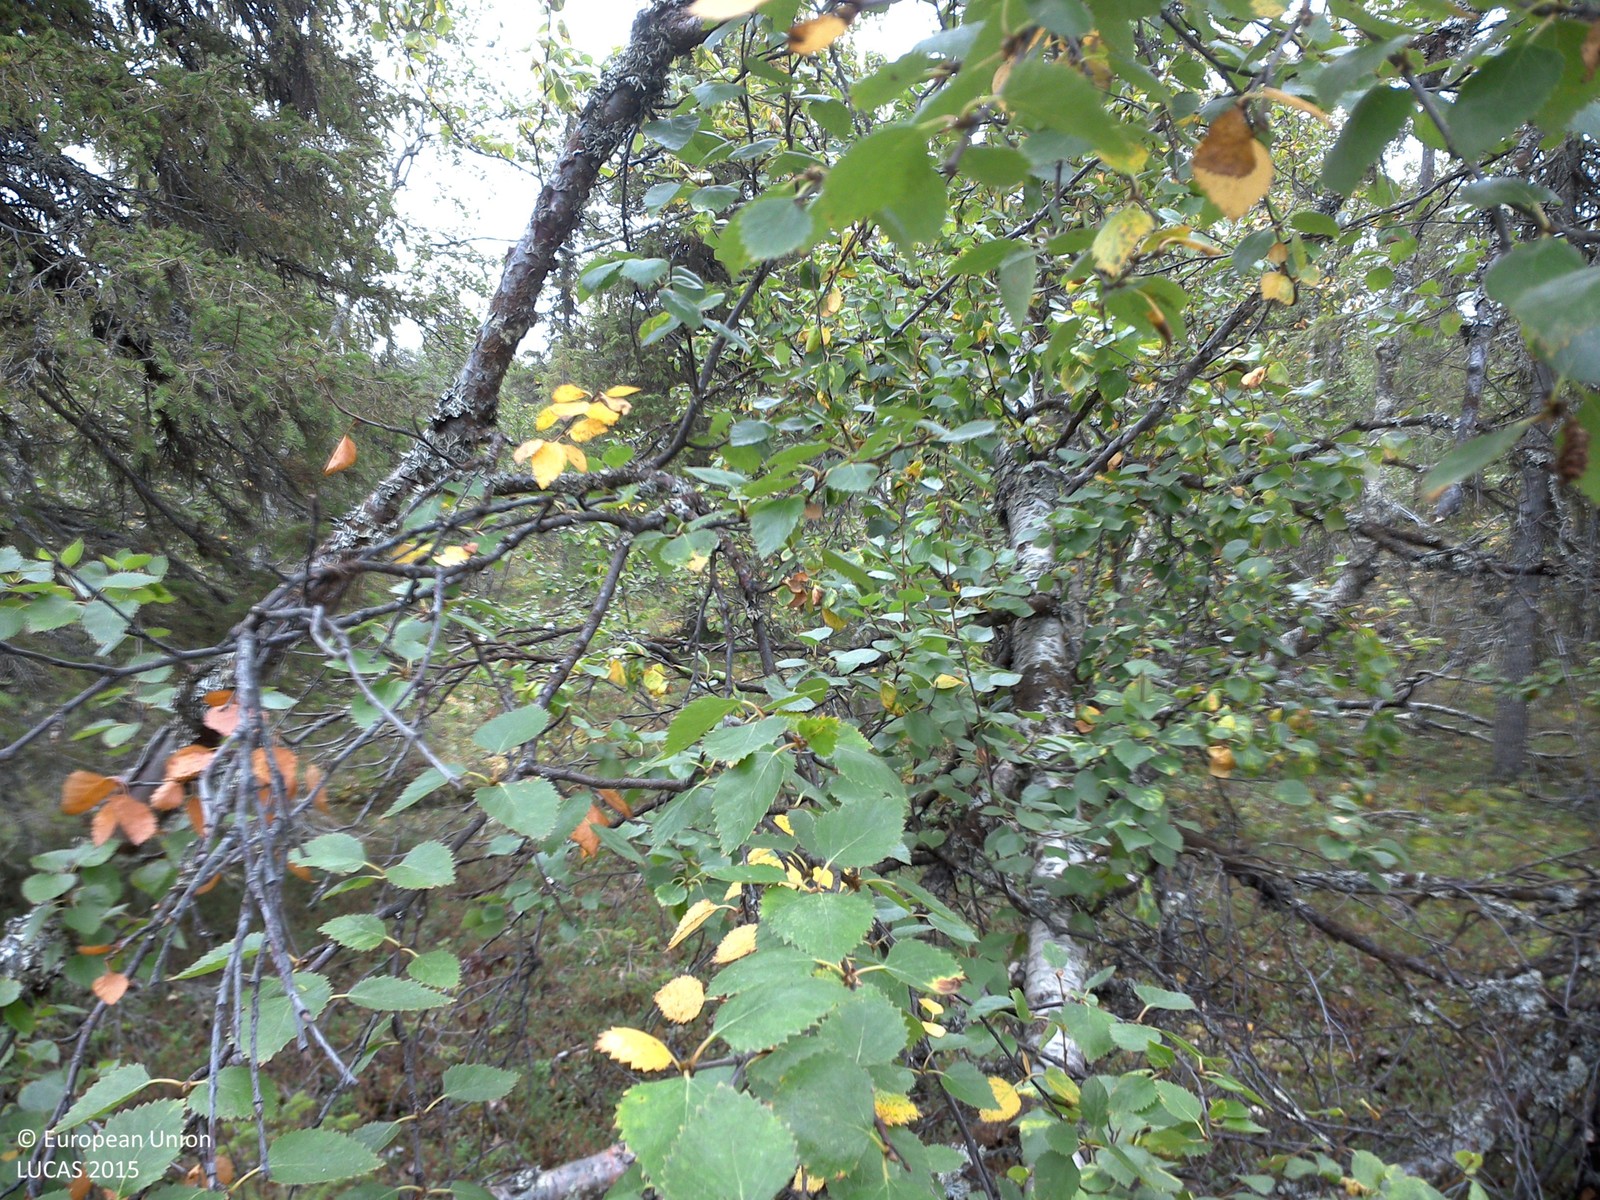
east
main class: Woodland
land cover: Spruce dominated mixed woodland
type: boreal forest
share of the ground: 25 - 50 %
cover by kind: shrubs 50 %, coniferous forest trees 20 %, broadleaved forest trees 15 %, lichens and mosses 15 %
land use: Amenities, museums, leisure
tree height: > 5 m
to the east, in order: Spruce dominated mixed woodland
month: August
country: SE
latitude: 67.9966
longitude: 22.2659
